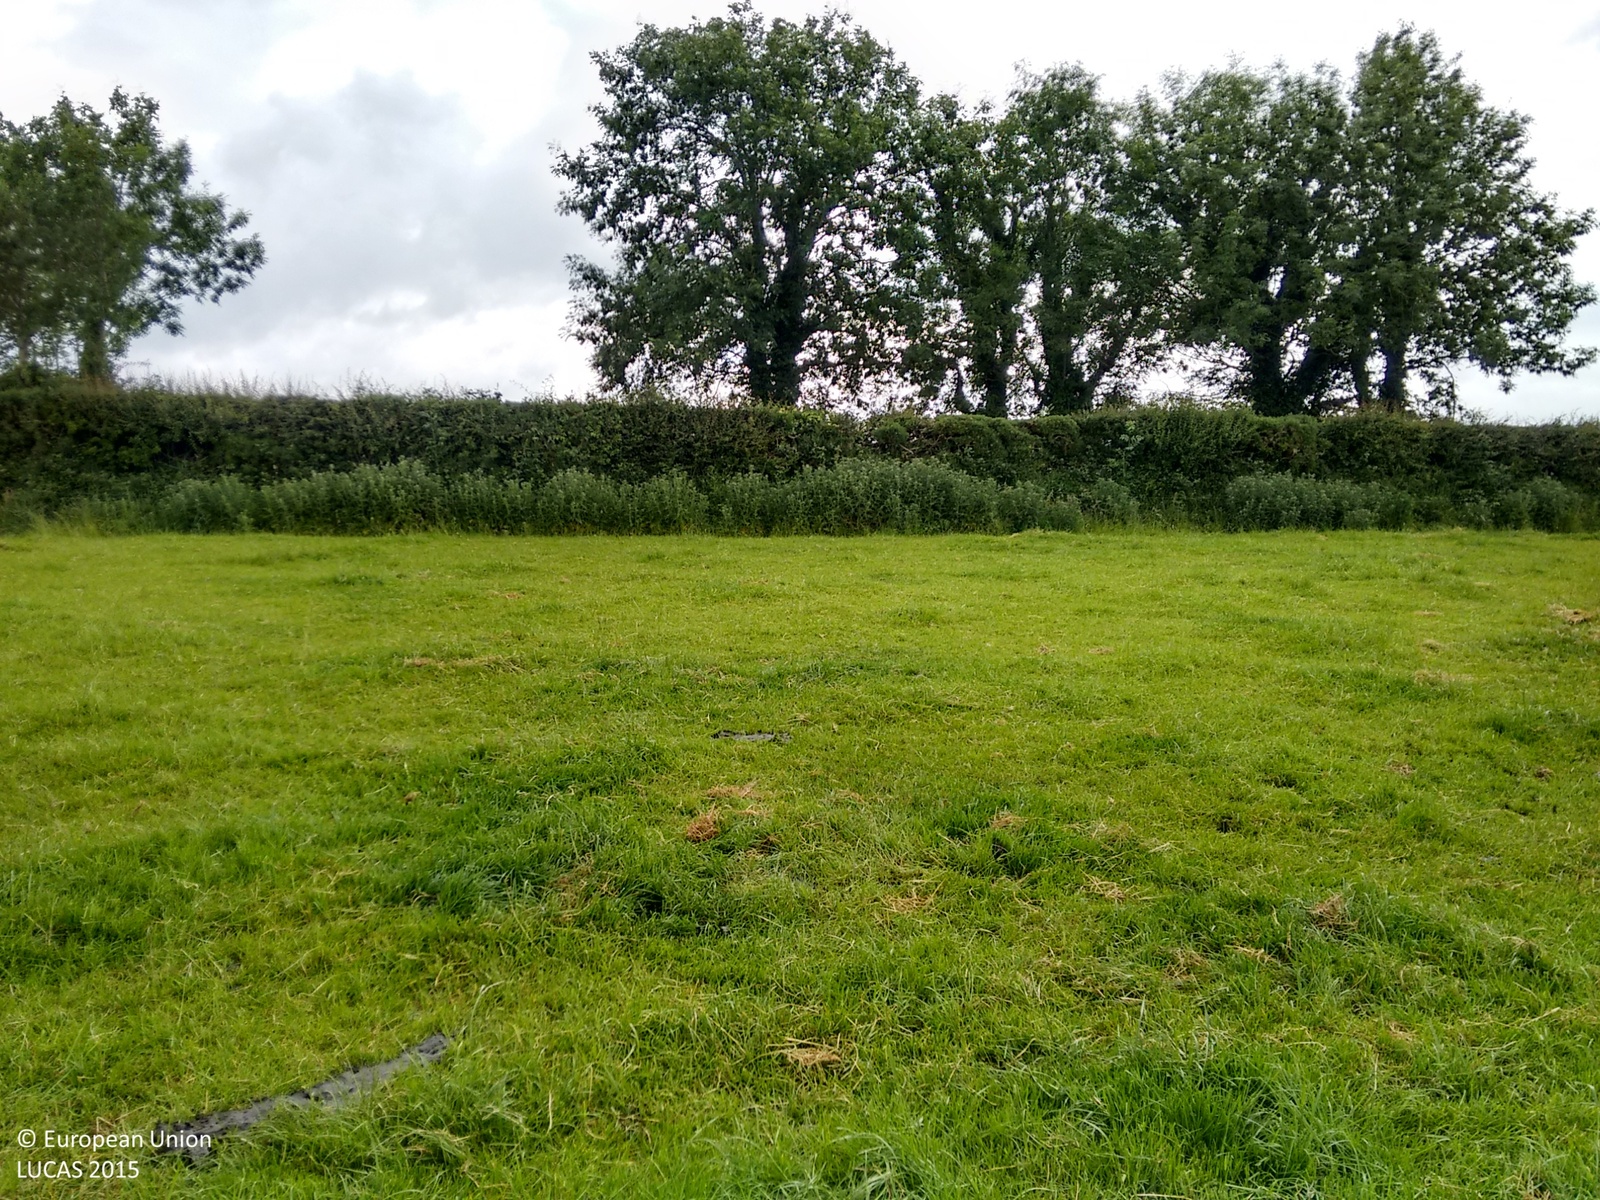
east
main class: Grassland
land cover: Grassland without tree/shrub cover
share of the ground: > 75 %
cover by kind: herbaceous plants 100 %
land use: Agriculture (excluding fallow land and kitchen gardens)
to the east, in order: Grassland without tree/shrub cover; Fences; Abandoned hedges; Tracks; Abandoned hedges; Fences; Grassland without tree/shrub cover
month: June
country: IE
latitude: 52.2872
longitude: -7.4413
